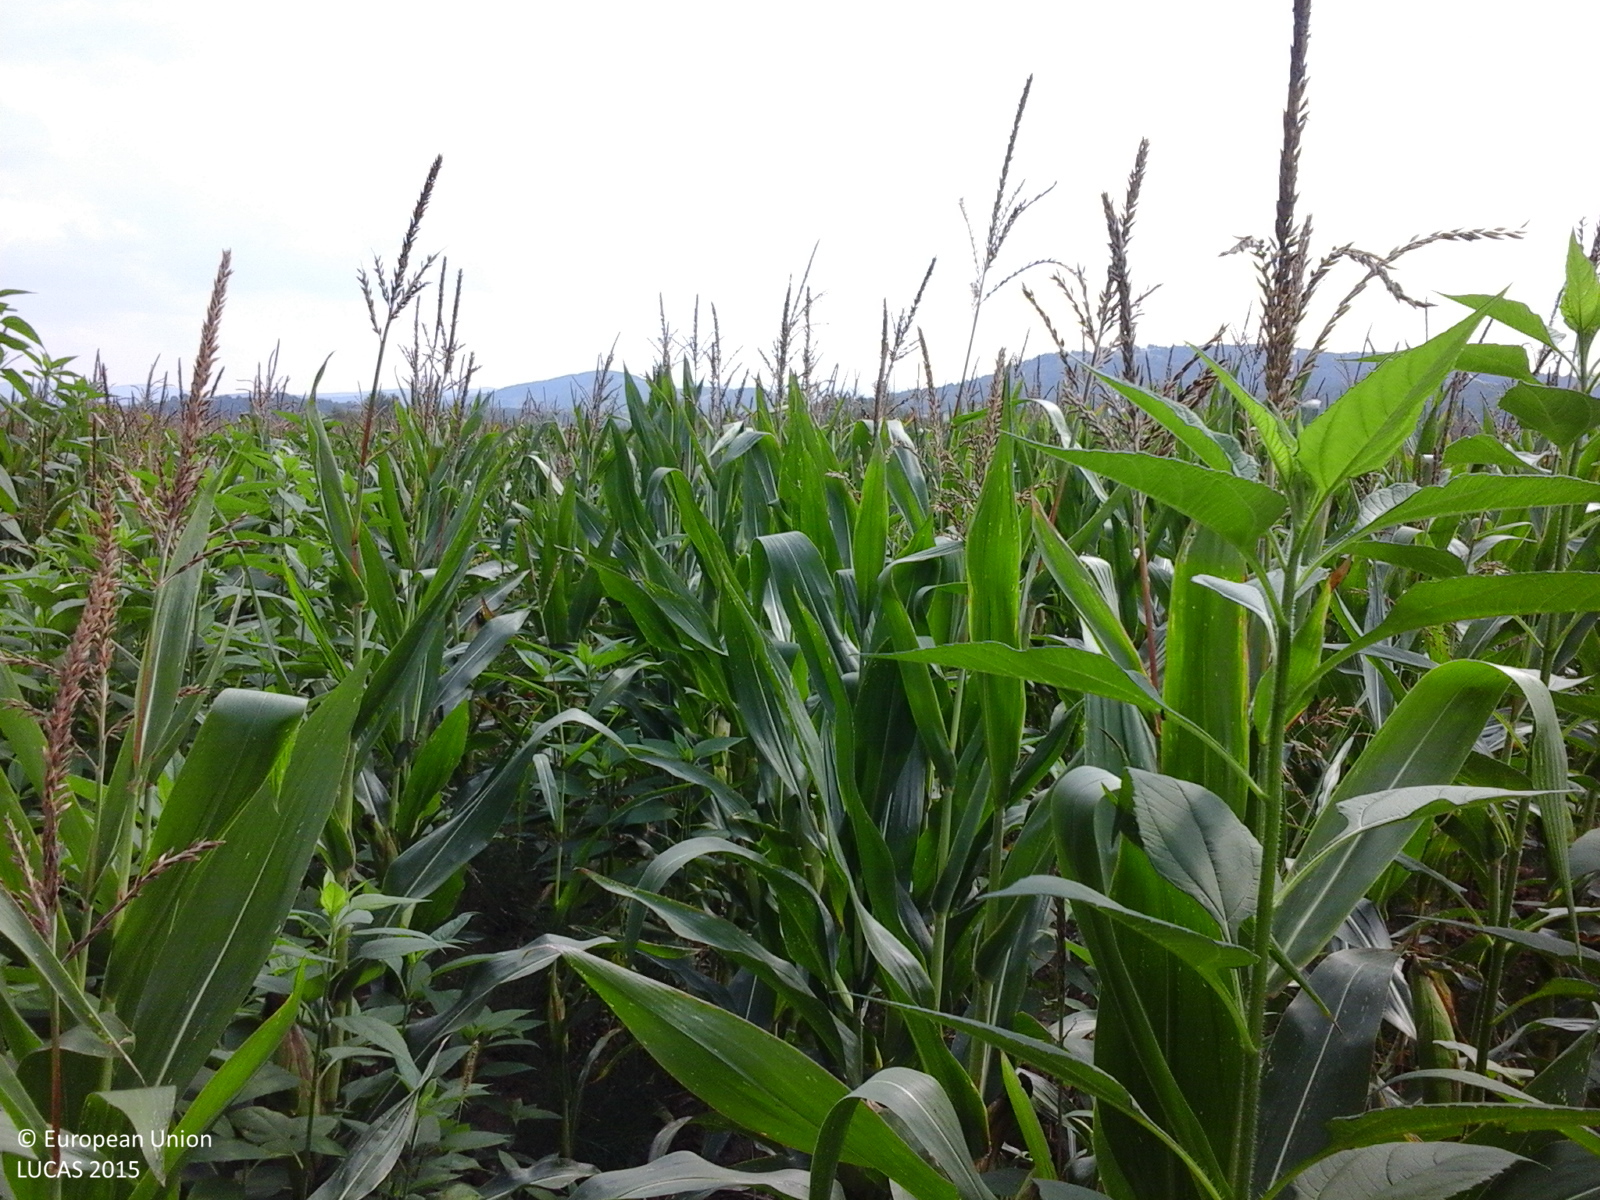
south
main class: Cropland
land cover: Maize
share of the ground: > 75 %
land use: Agriculture (excluding fallow land and kitchen gardens)
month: August
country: RO
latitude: 46.3040
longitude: 22.2119
